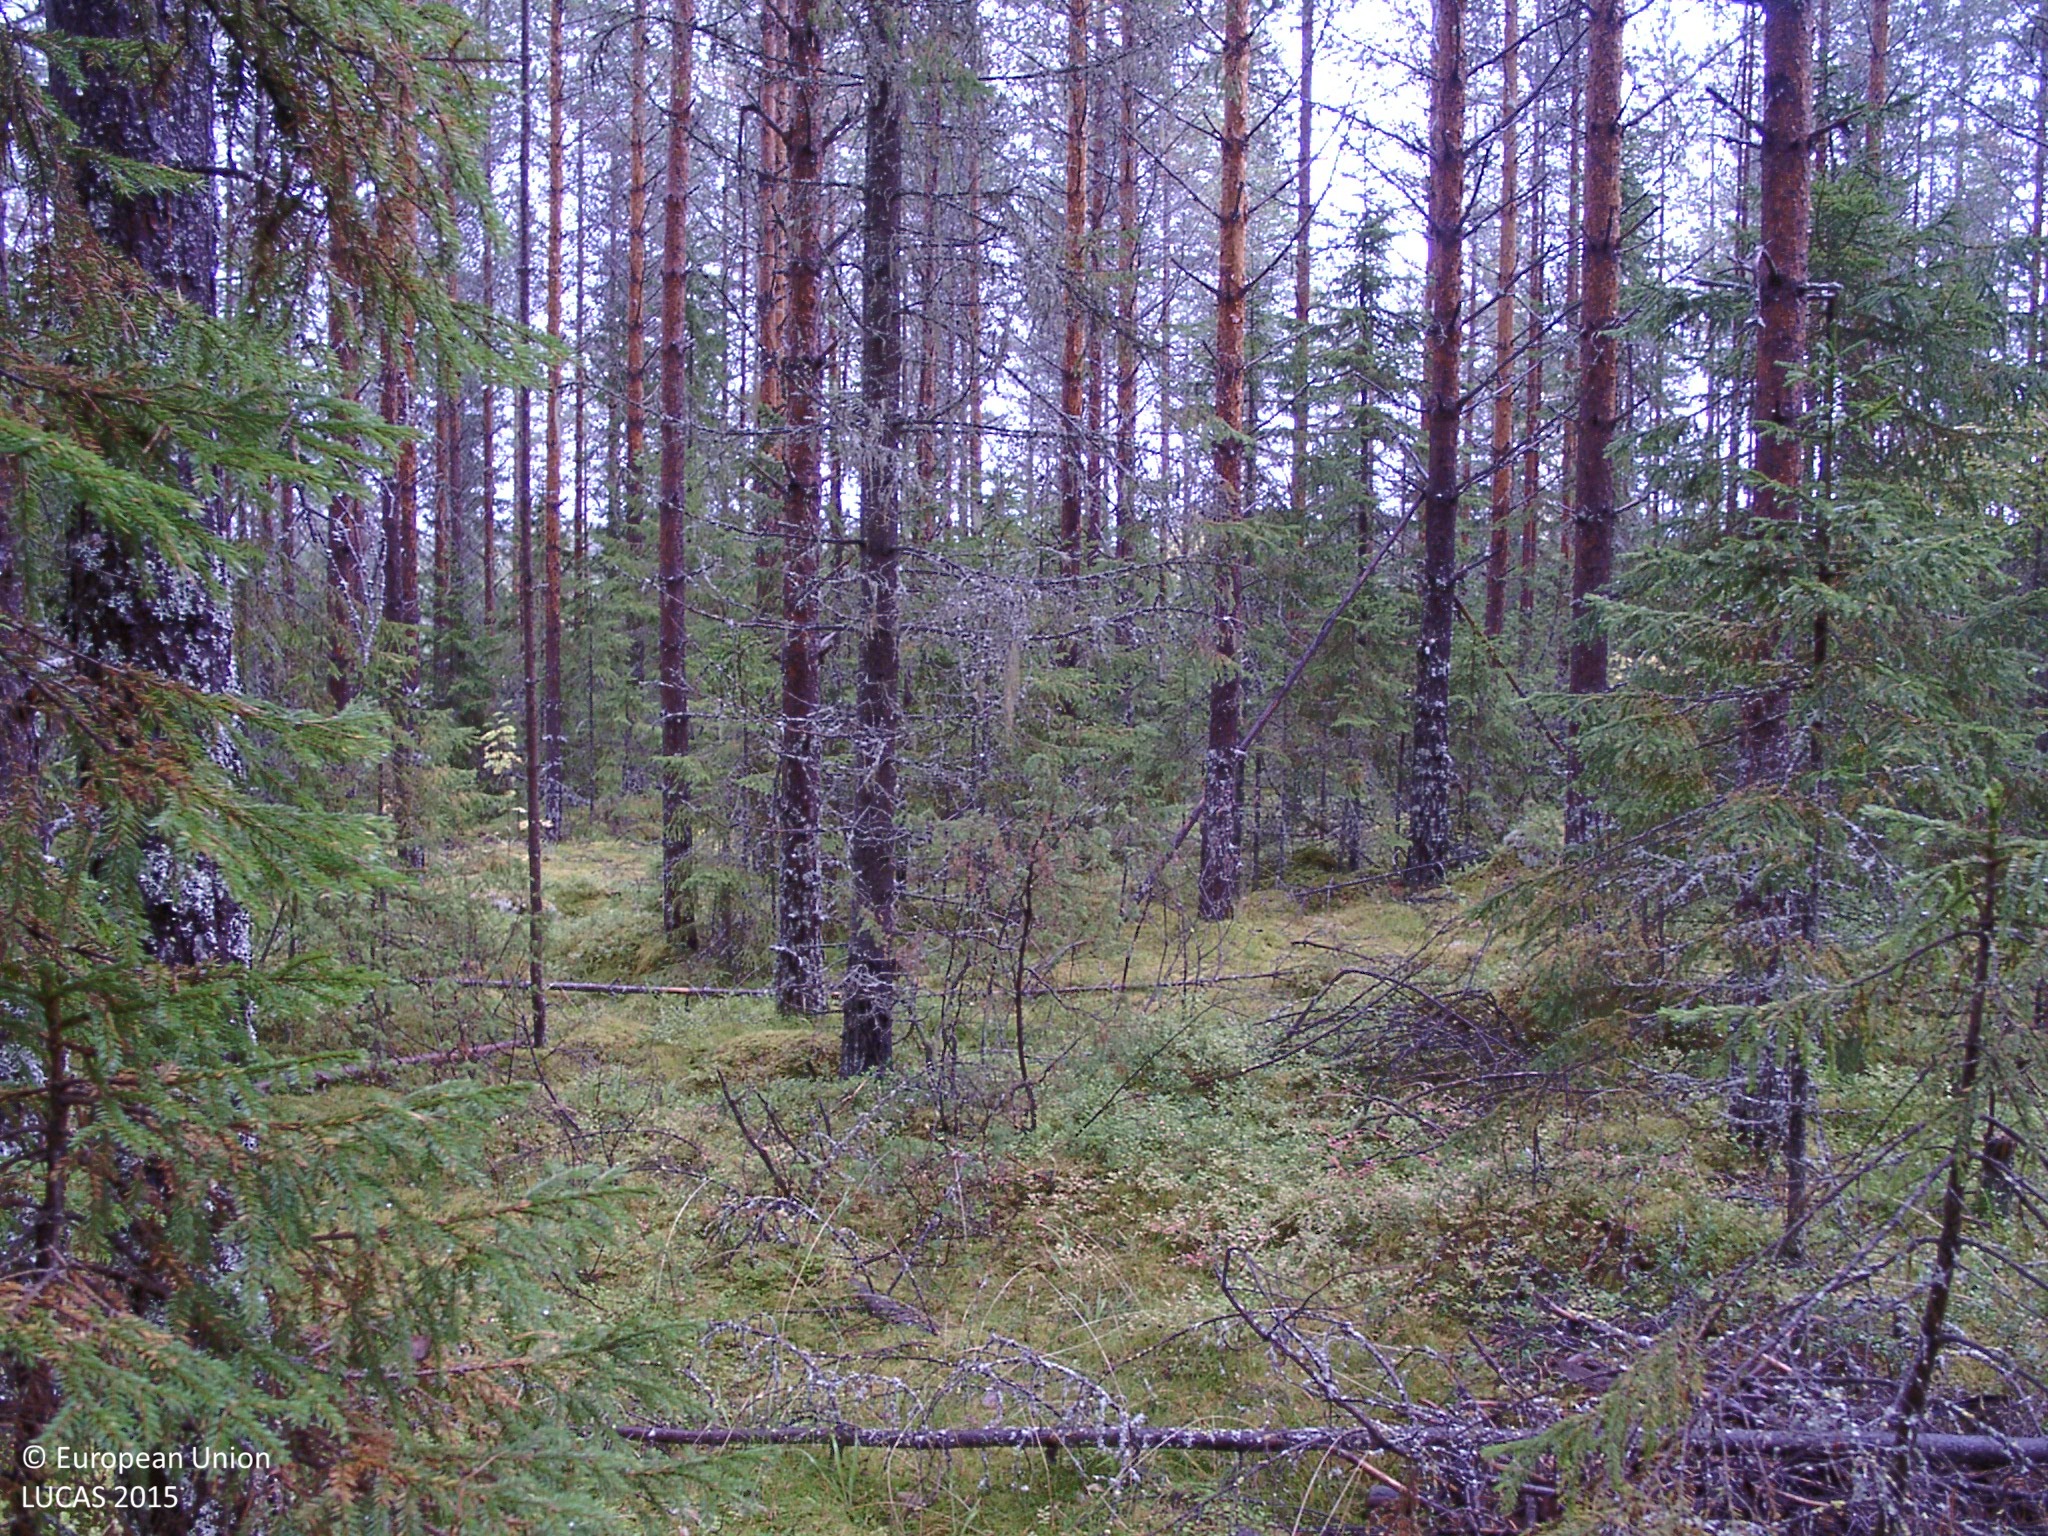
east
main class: Woodland
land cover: Other coniferous woodland
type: boreal forest
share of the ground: 50 - 75 %
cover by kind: coniferous forest trees 65 %, shrubs 15 %, lichens and mosses 15 %, herbaceous plants 5 %
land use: Forestry
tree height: > 5 m
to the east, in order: Other coniferous woodland; Shruby margins; Other coniferous woodland; Shruby margins; Other coniferous woodland; Pine dominated coniferous woodland
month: September
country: FI
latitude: 62.7786
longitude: 25.6920
